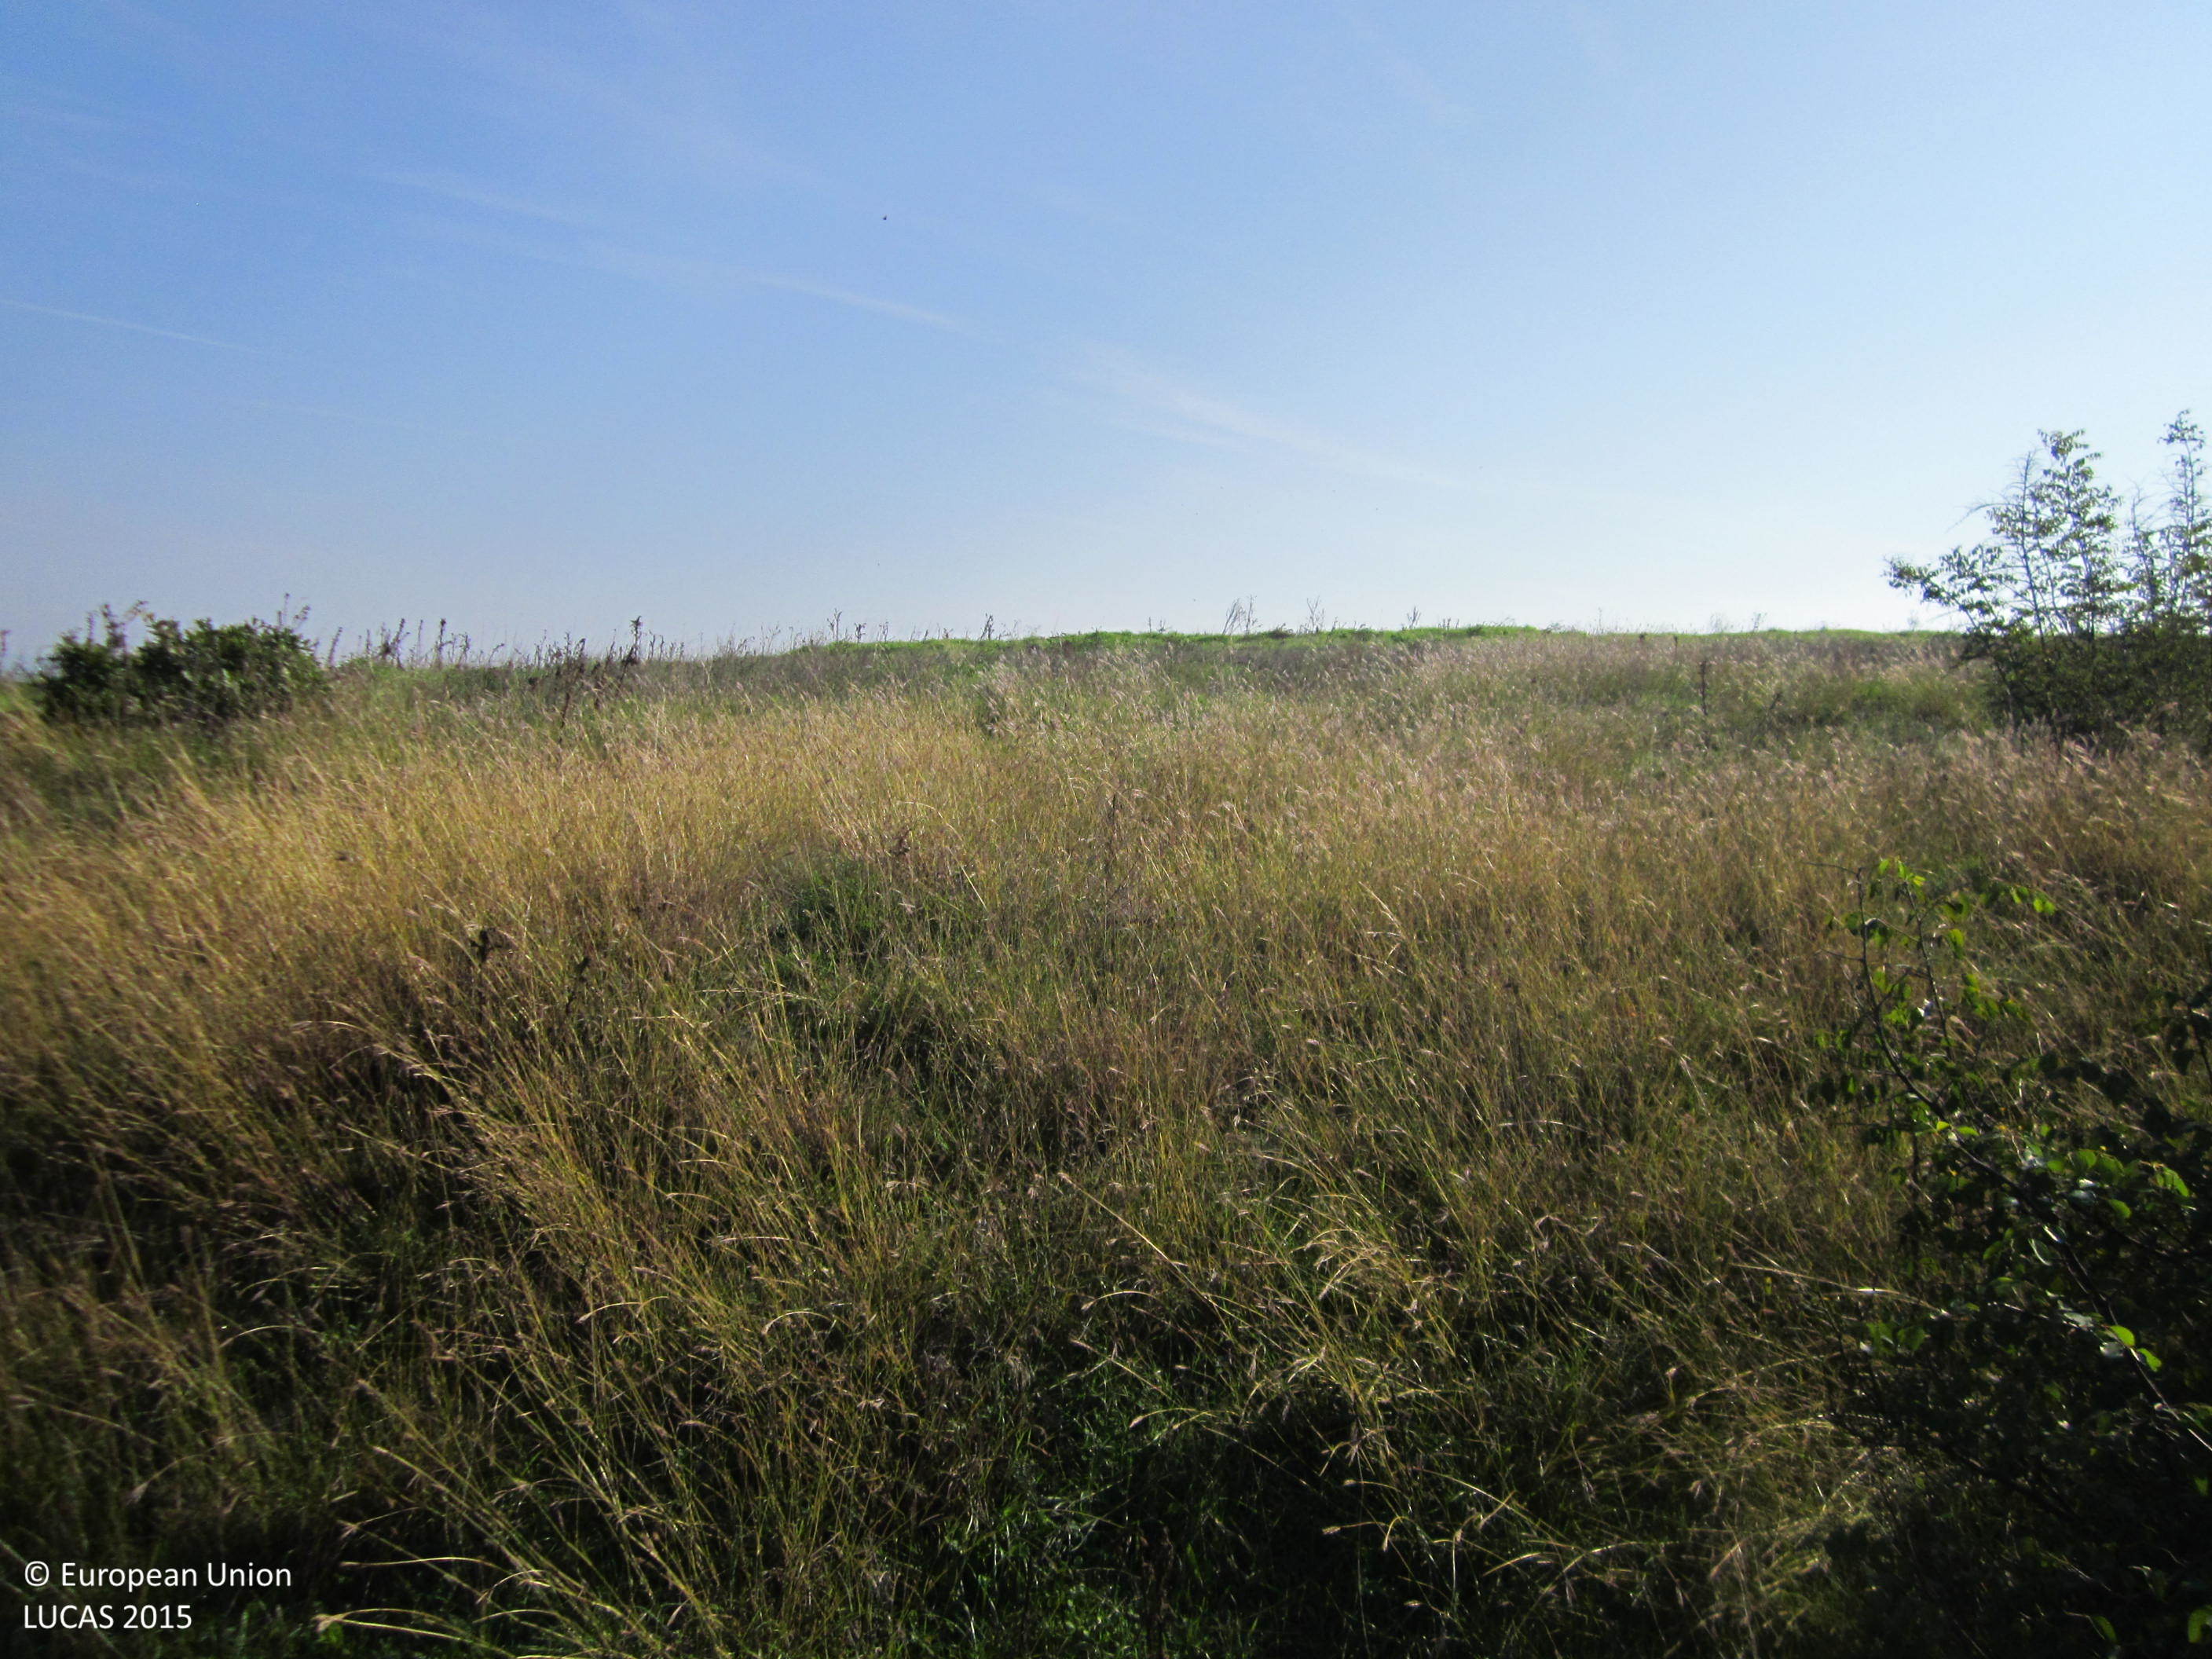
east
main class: Shrubland
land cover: Shrubland without tree cover
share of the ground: 25 - 50 %
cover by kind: herbaceous plants 55 %, shrubs 45 %
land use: Semi-natural and natural areas not in use
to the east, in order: Shrubland without tree cover; Grassland without tree/shrub cover; Rape and turnip rape
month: October
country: BG
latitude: 42.6829
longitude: 26.8598
